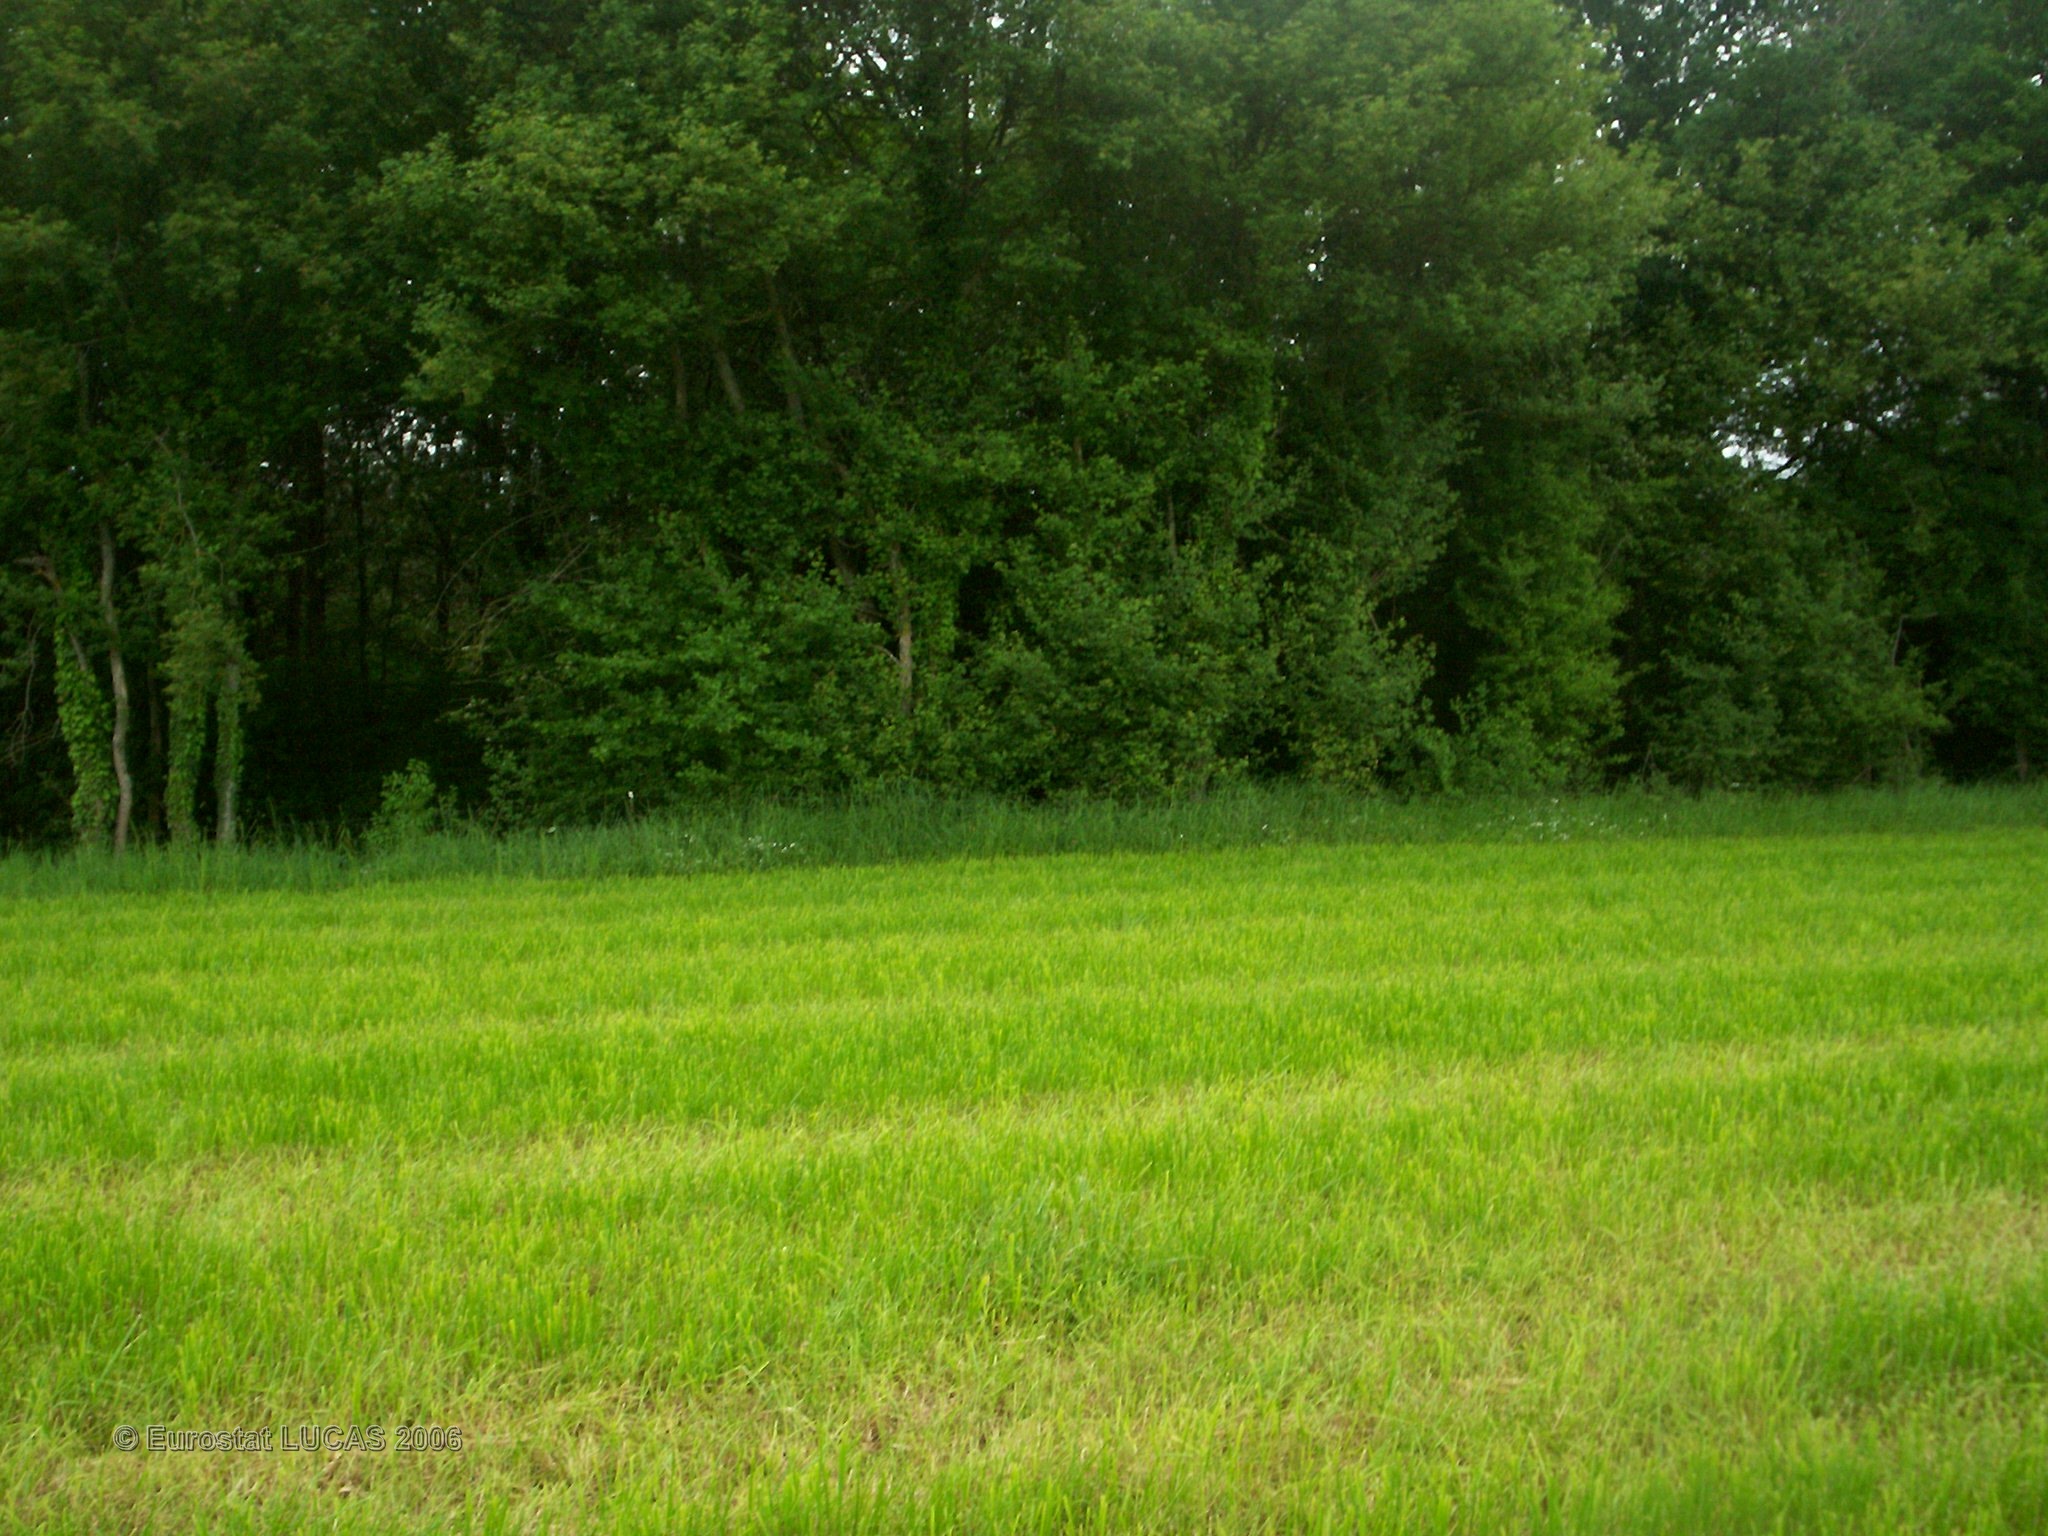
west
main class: Grassland
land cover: Grassland without tree/shrub cover
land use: Agriculture (excluding fallow land and kitchen gardens)
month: May
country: FR
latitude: 47.7961
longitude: 2.9041
